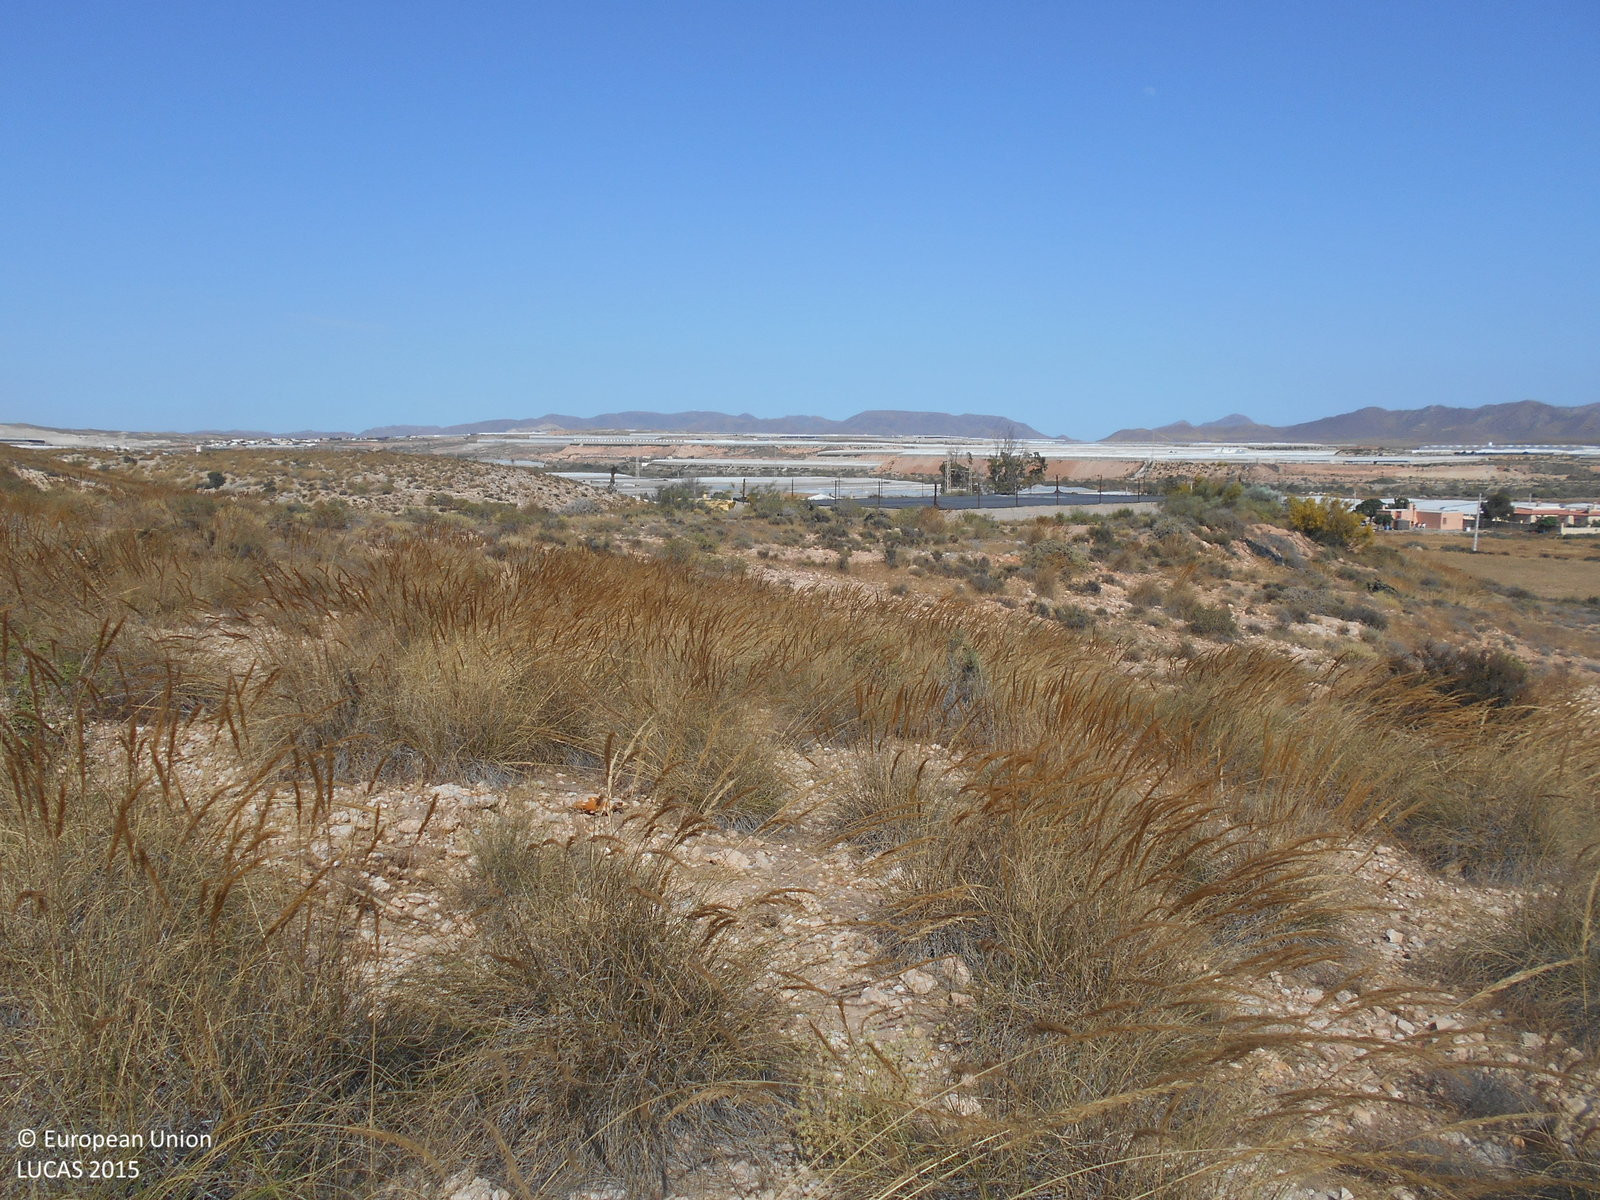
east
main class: Shrubland
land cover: Shrubland without tree cover
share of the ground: 25 - 50 %
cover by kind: shrubs 40 %, unconsolidated bare surface 30 %, consolidated bare surface 20 %, herbaceous plants 10 %
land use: Semi-natural and natural areas not in use
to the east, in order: Shrubland without tree cover; Dry stone walls; Inland fresh water bodies; Dry stone walls; Shrubland without tree cover; Electric lines; Paved roads, cycling and walking lanes
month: May
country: ES
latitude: 36.8269
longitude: -2.2279
